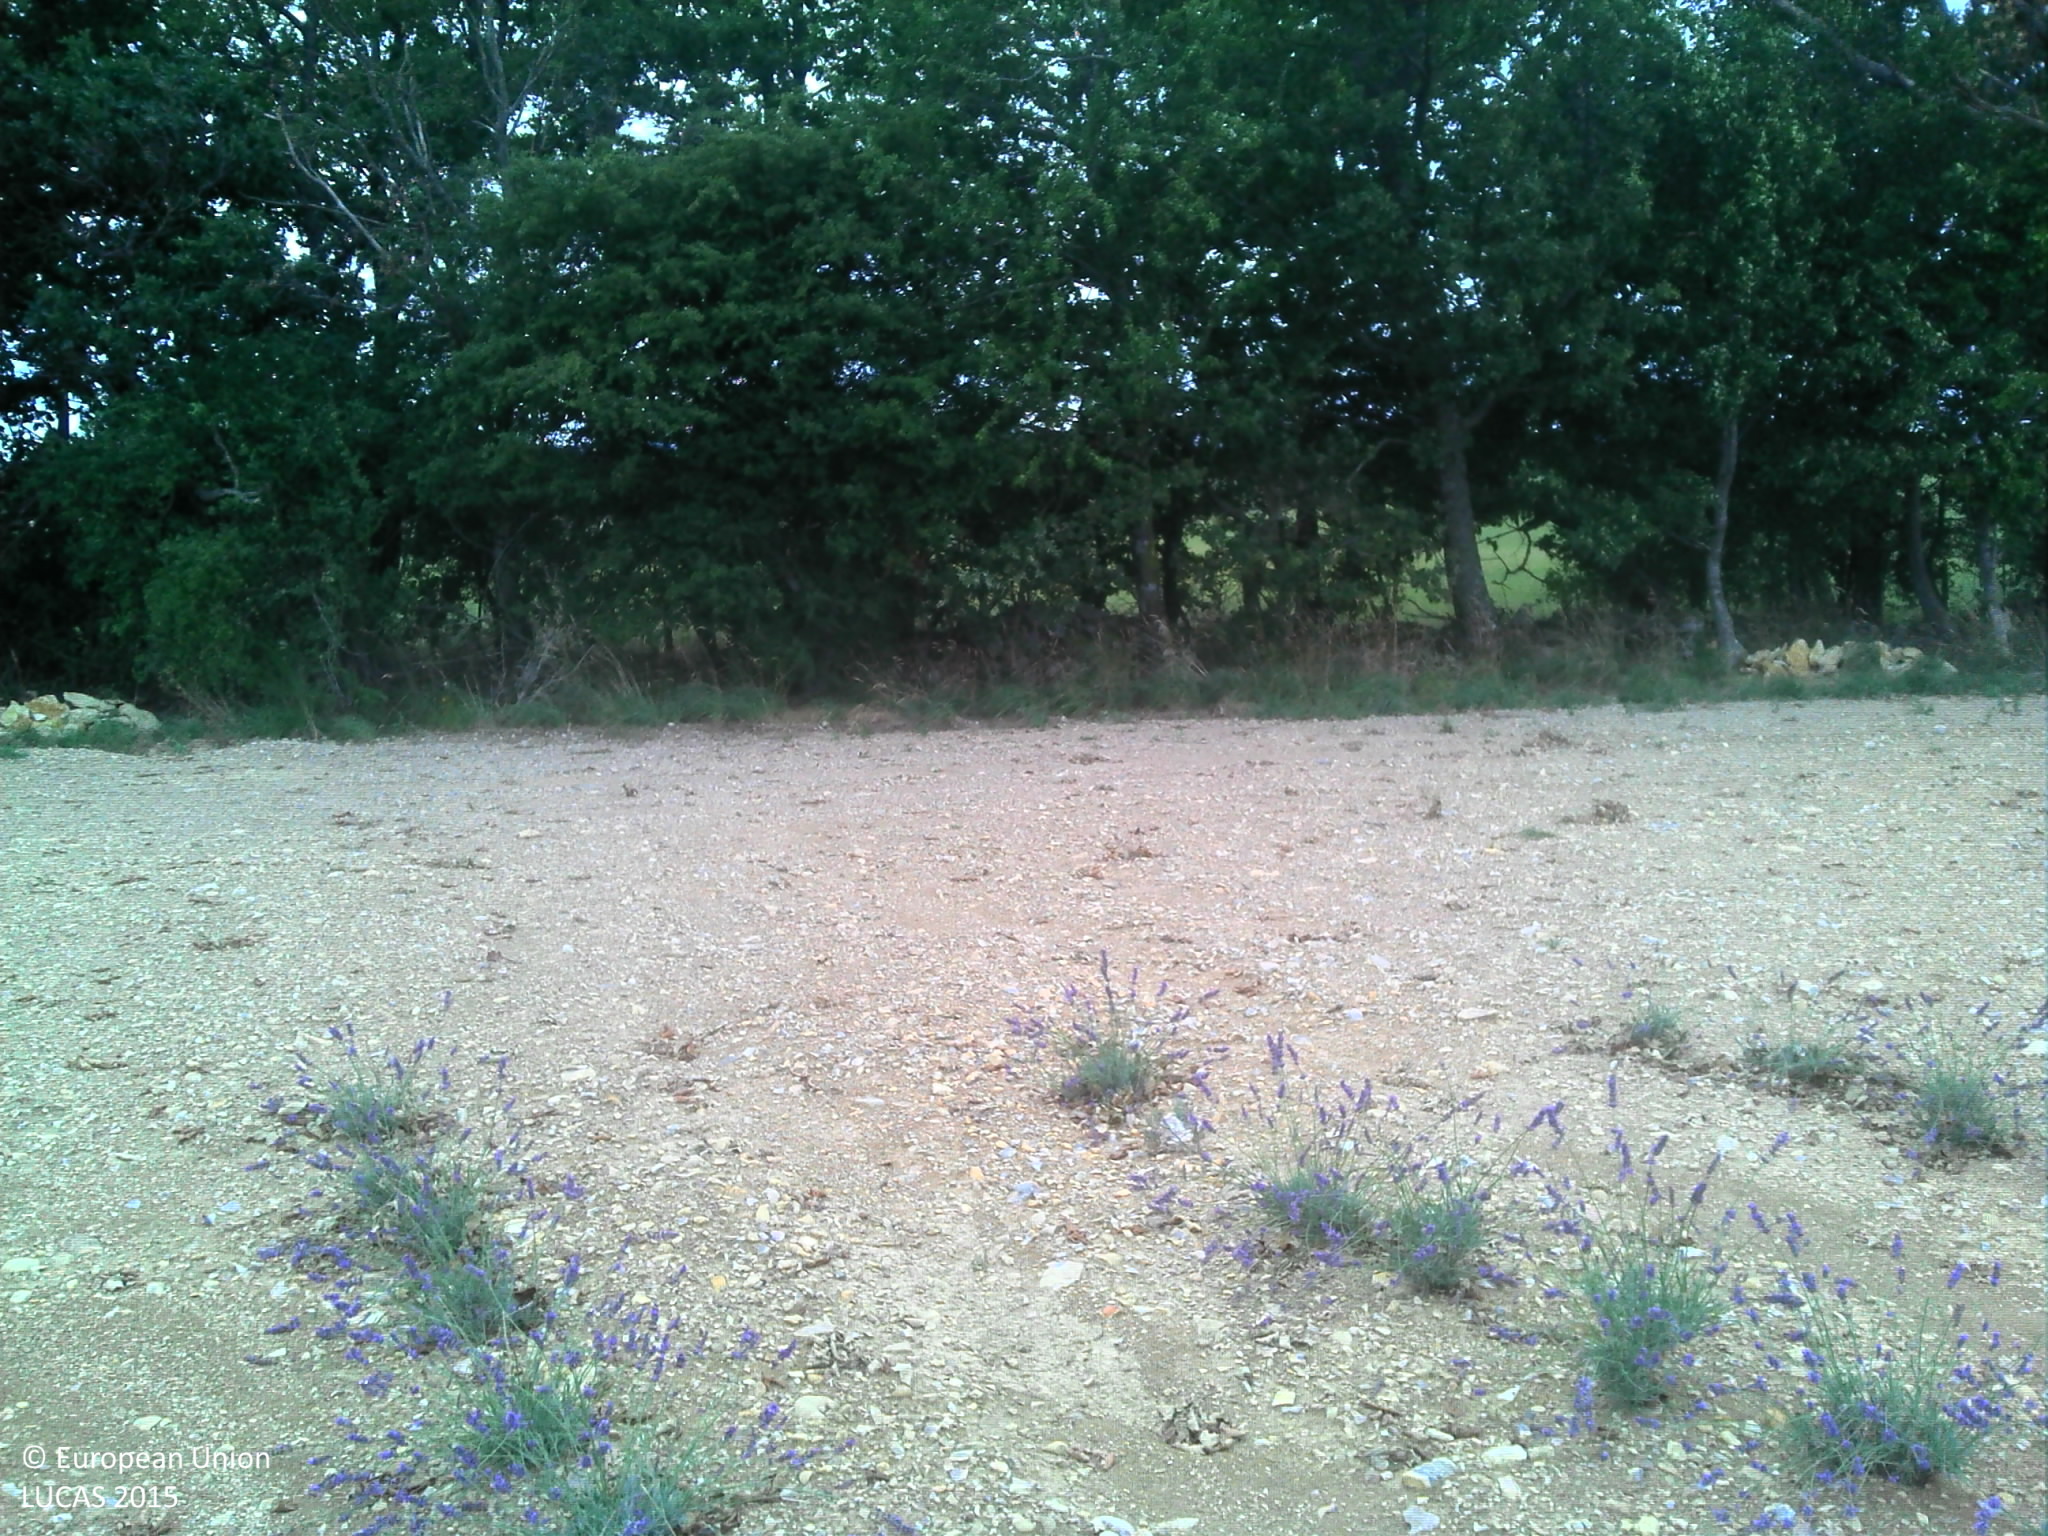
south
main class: Cropland
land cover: Permanent industrial crops
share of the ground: 10 - 25 %
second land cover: Other bare soil
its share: > 75 %
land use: Agriculture (excluding fallow land and kitchen gardens)
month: July
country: FR
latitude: 44.0735
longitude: 5.5255
